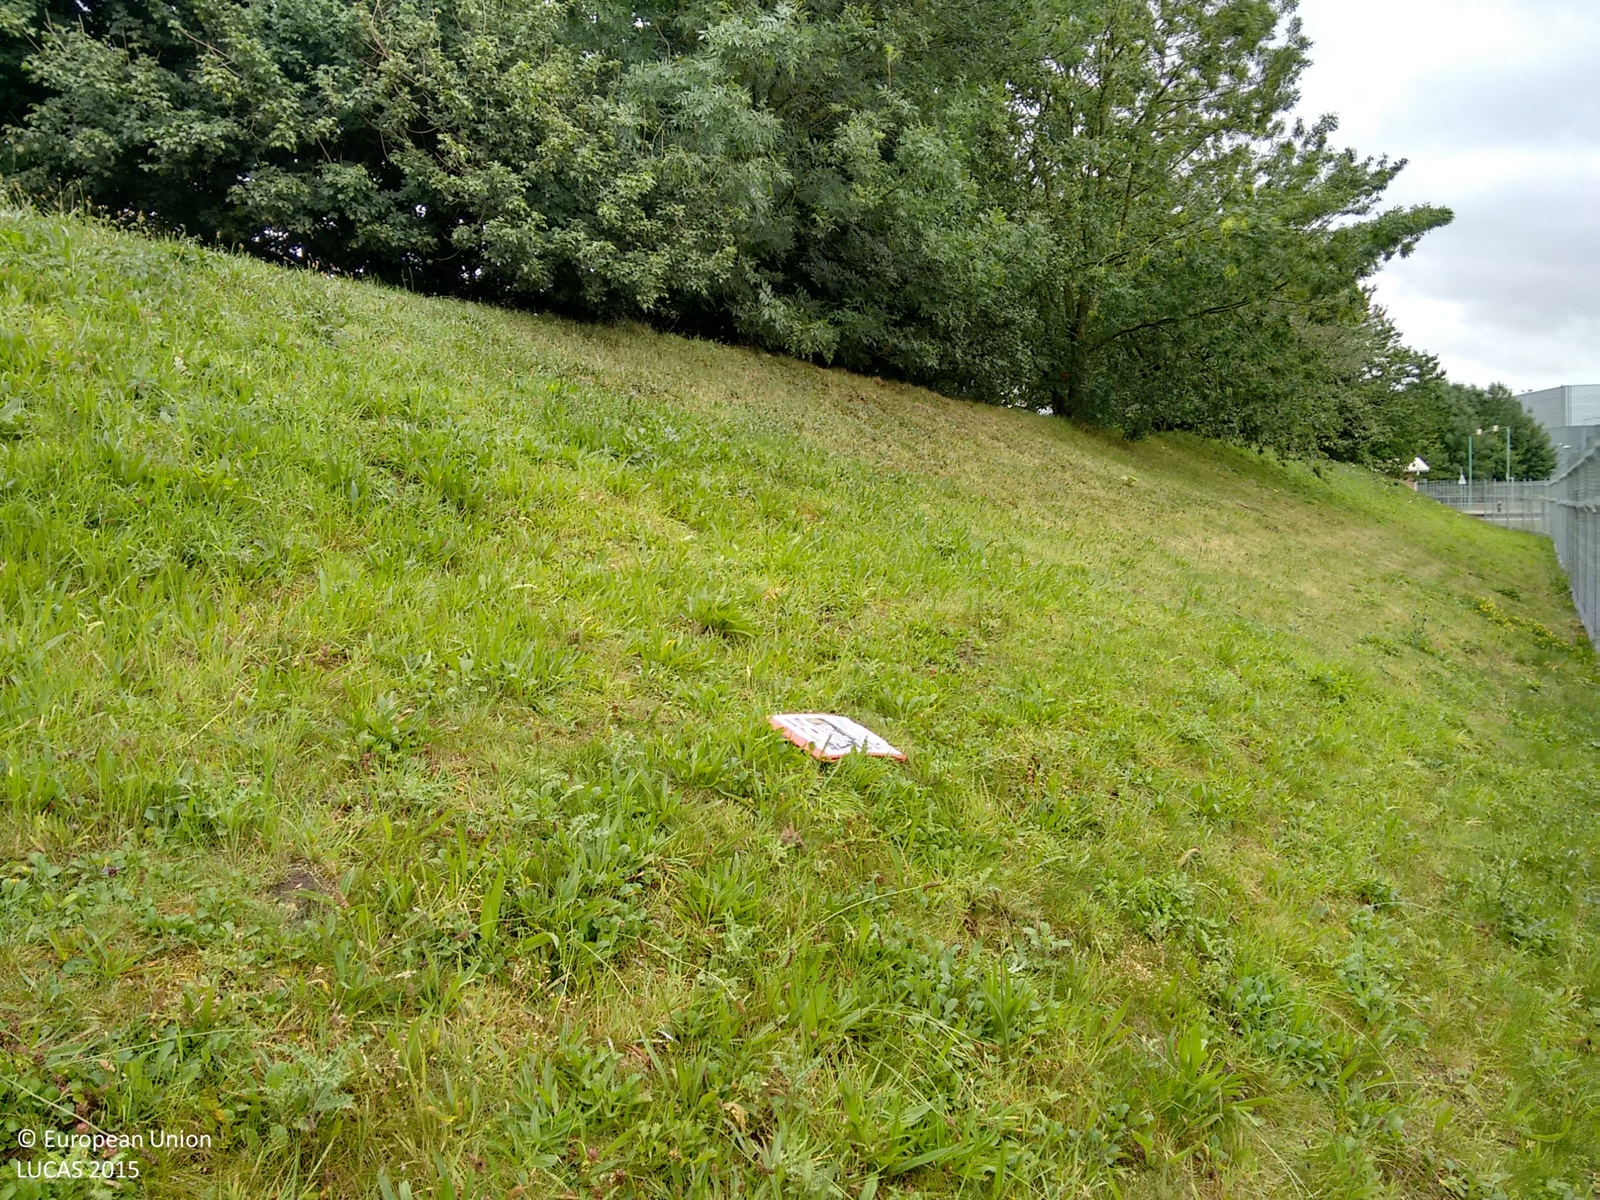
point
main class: Grassland
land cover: Grassland without tree/shrub cover
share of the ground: > 75 %
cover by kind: herbaceous plants 100 %
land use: Logistics and storage
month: August
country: GB
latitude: 52.7038
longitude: -1.3405
